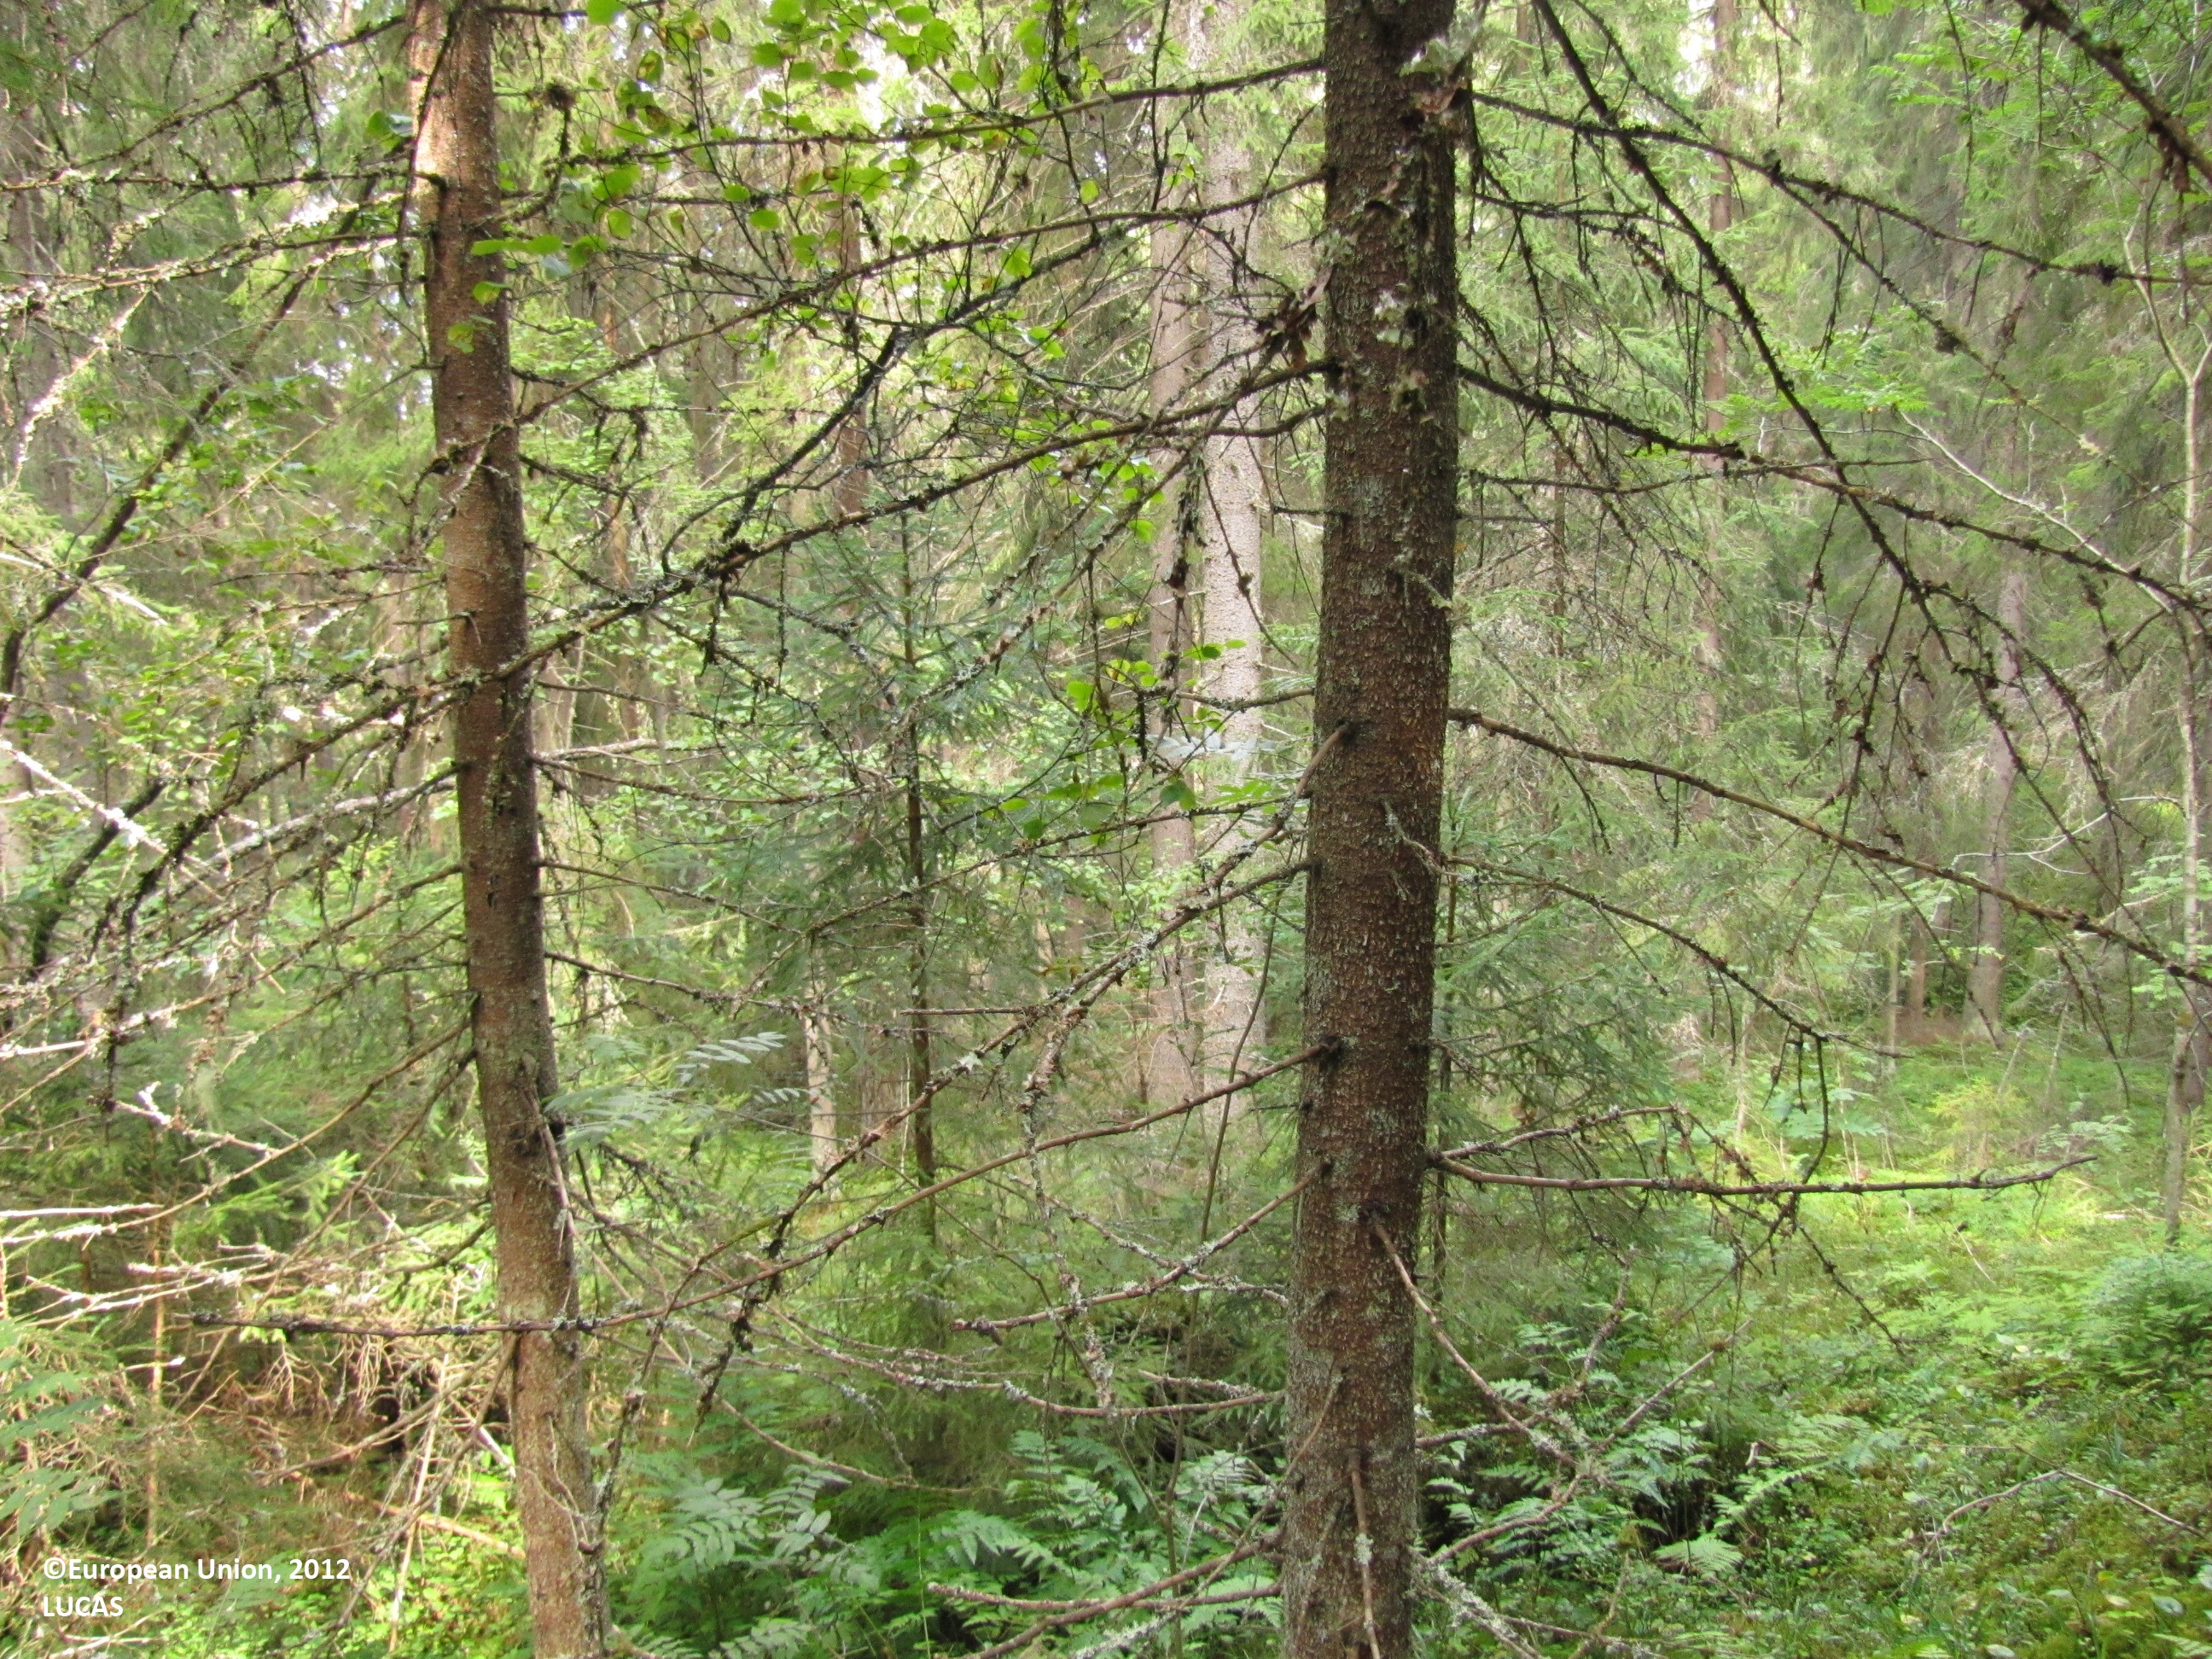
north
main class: Woodland
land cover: Spruce dominated coniferous woodland
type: boreal forest
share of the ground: 50 - 75 %
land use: Forestry
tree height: > 5 m
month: August
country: FI
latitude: 61.7390
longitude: 23.1537
